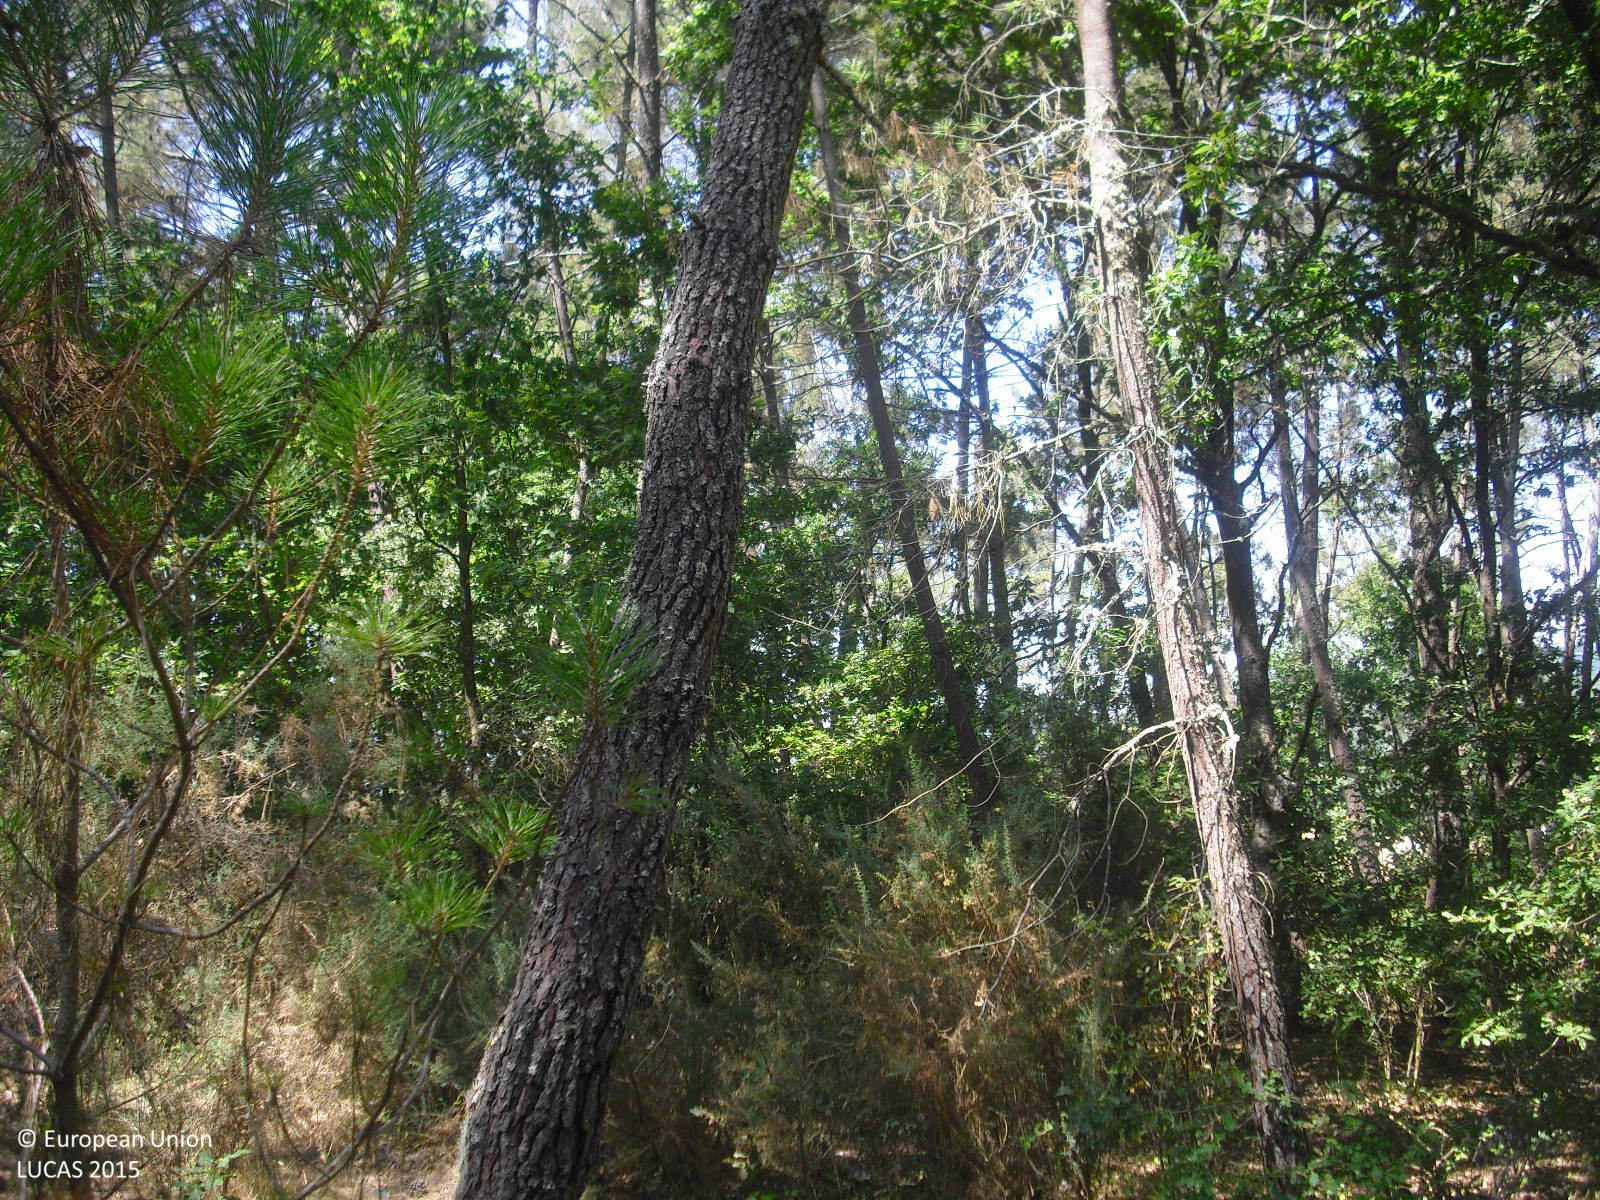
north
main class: Woodland
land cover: Pine dominated mixed woodland
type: hemiboreal forest and nemoral coniferous forest and mixed broadleaved-coniferous forest
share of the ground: 50 - 75 %
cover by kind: coniferous forest trees 45 %, broadleaved forest trees 35 %, shrubs 20 %
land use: Forestry
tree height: > 5 m
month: July
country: ES
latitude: 42.5063
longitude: -7.4587
